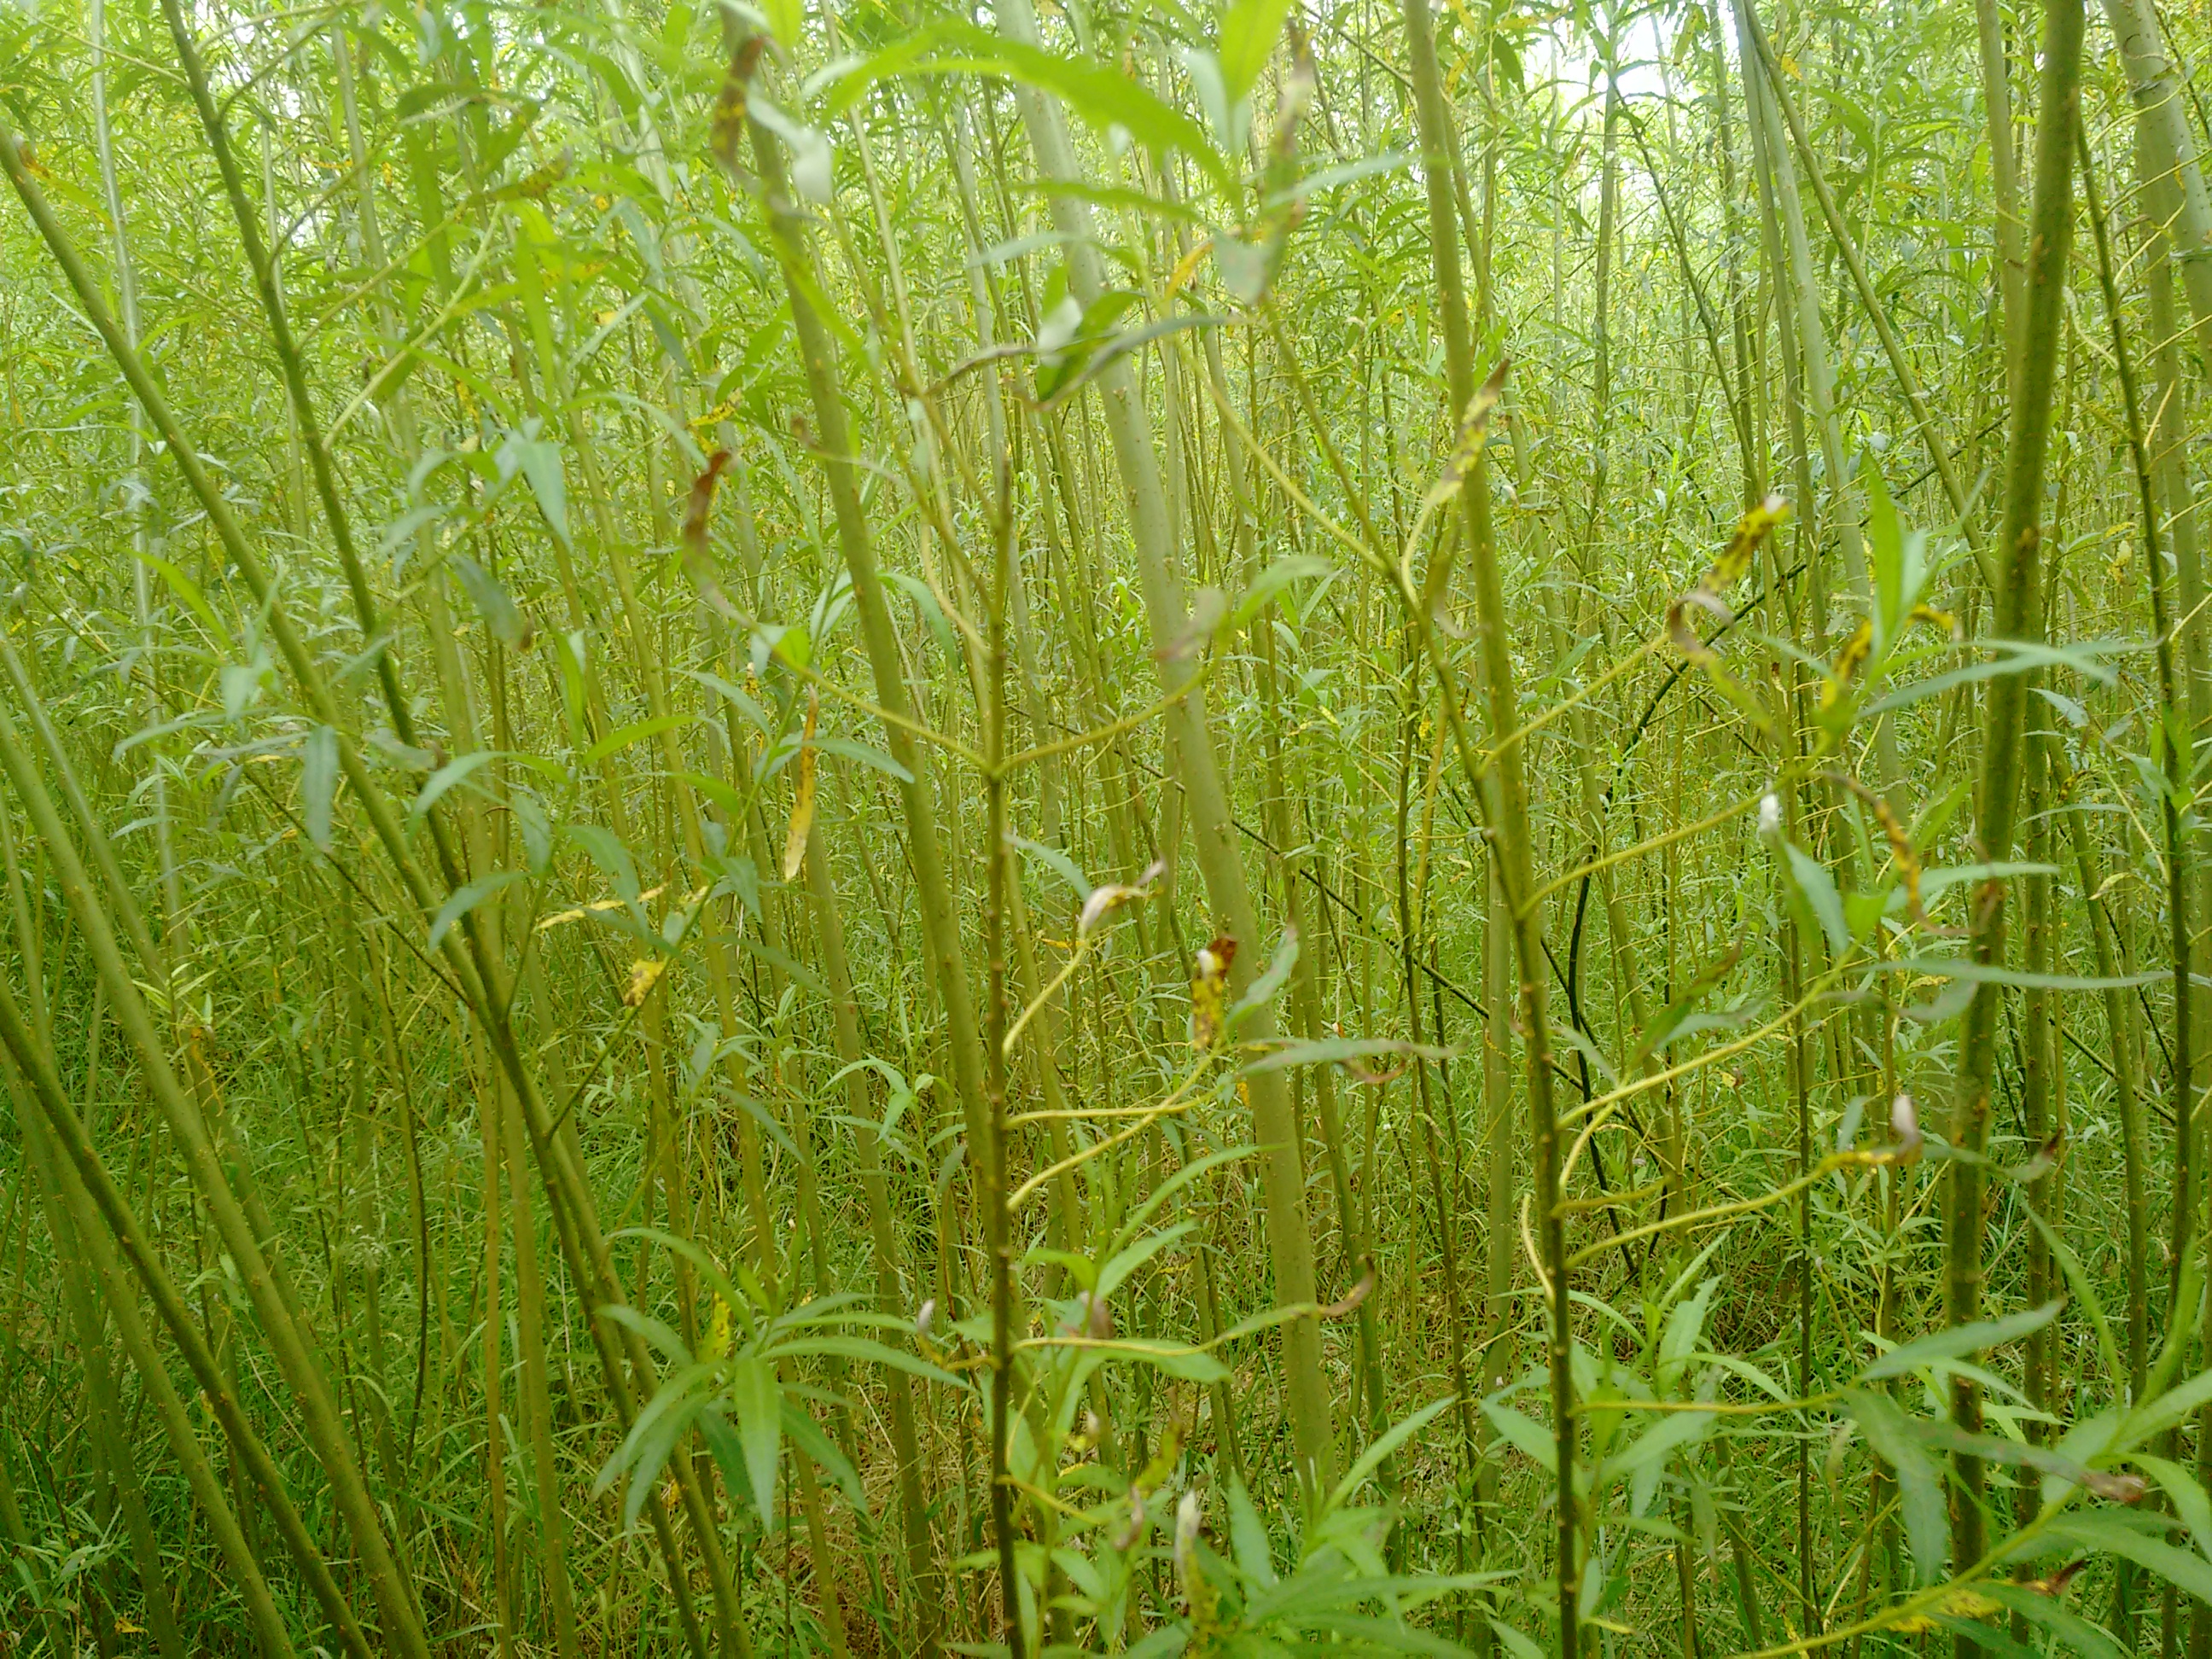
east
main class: Cropland
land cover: Permanent industrial crops
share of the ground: > 75 %
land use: Agriculture (excluding fallow land and kitchen gardens)
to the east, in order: Permanent industrial crops; Grass margins; Fences; Broadleaved woodland; Rivers and streams; Shrubland without tree cover; Pine dominated coniferous woodland; Abandoned hedges
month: June
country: IE
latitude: 53.3810
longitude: -7.6469
